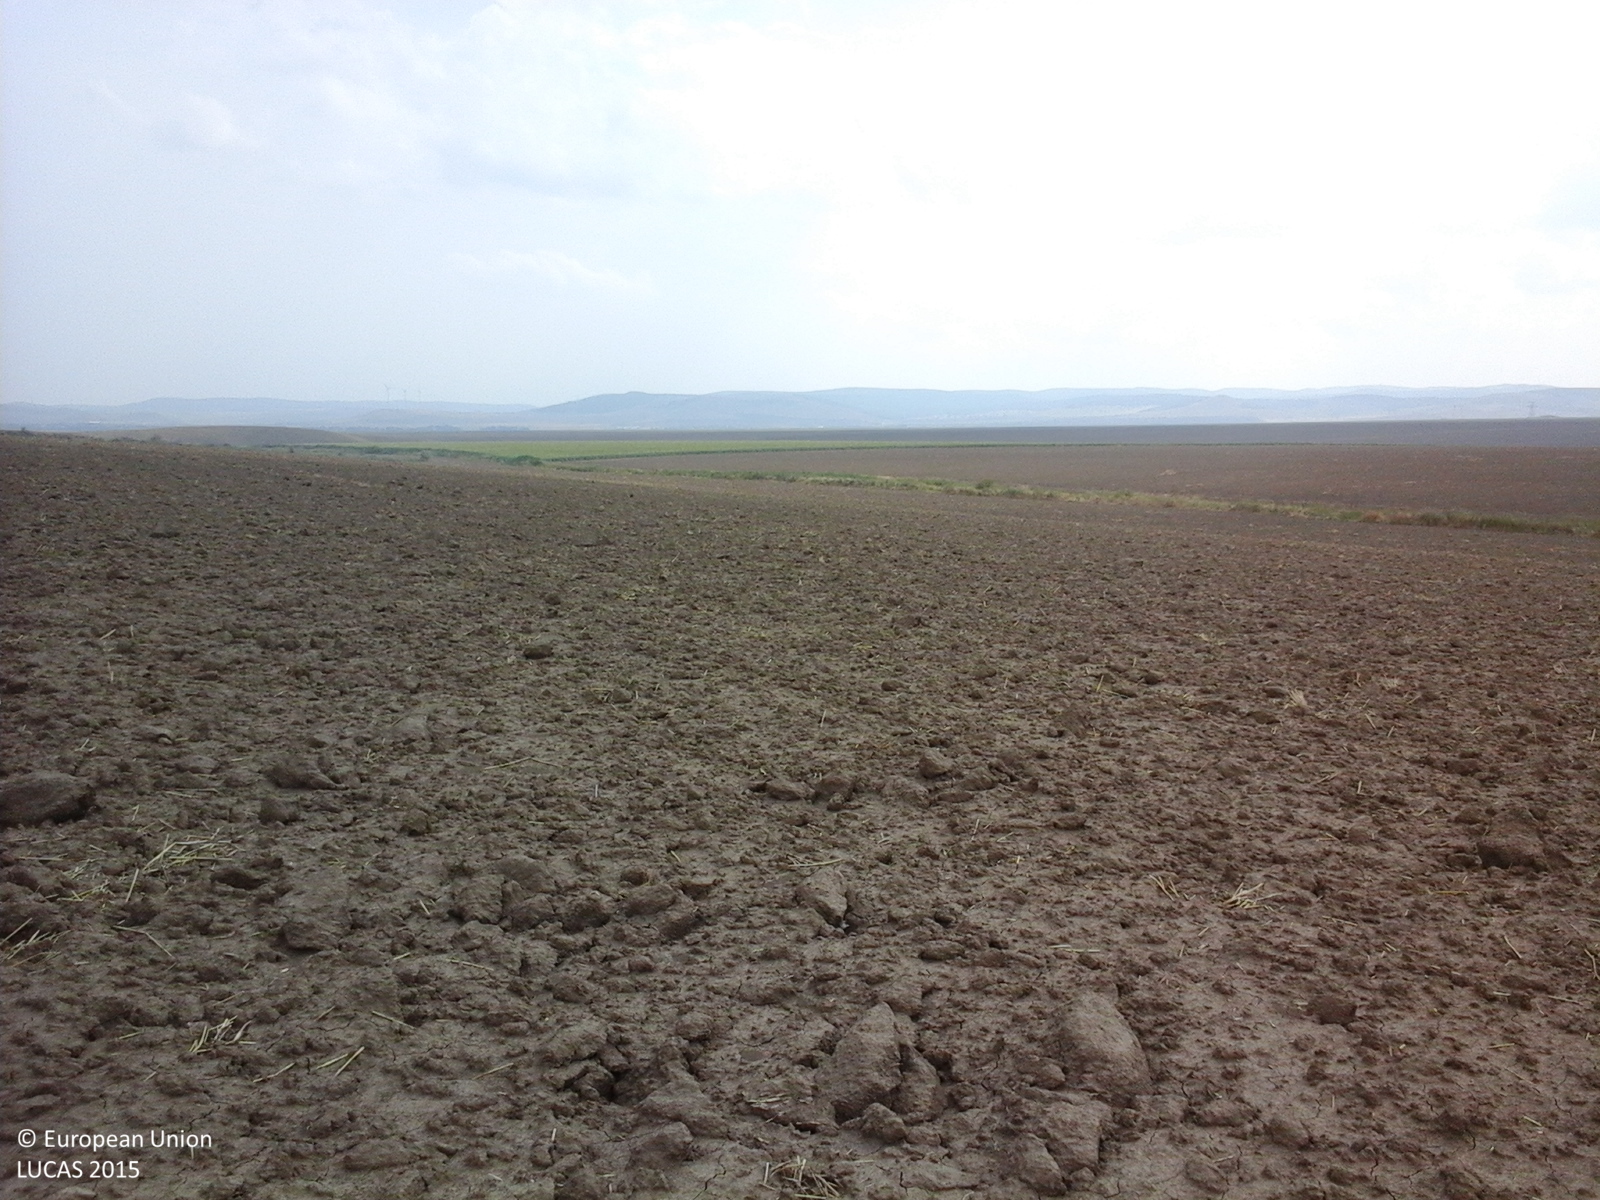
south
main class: Cropland
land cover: Oats
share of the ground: < 10 %
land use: Agriculture (excluding fallow land and kitchen gardens)
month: July
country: RO
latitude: 45.0241
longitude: 28.6506
